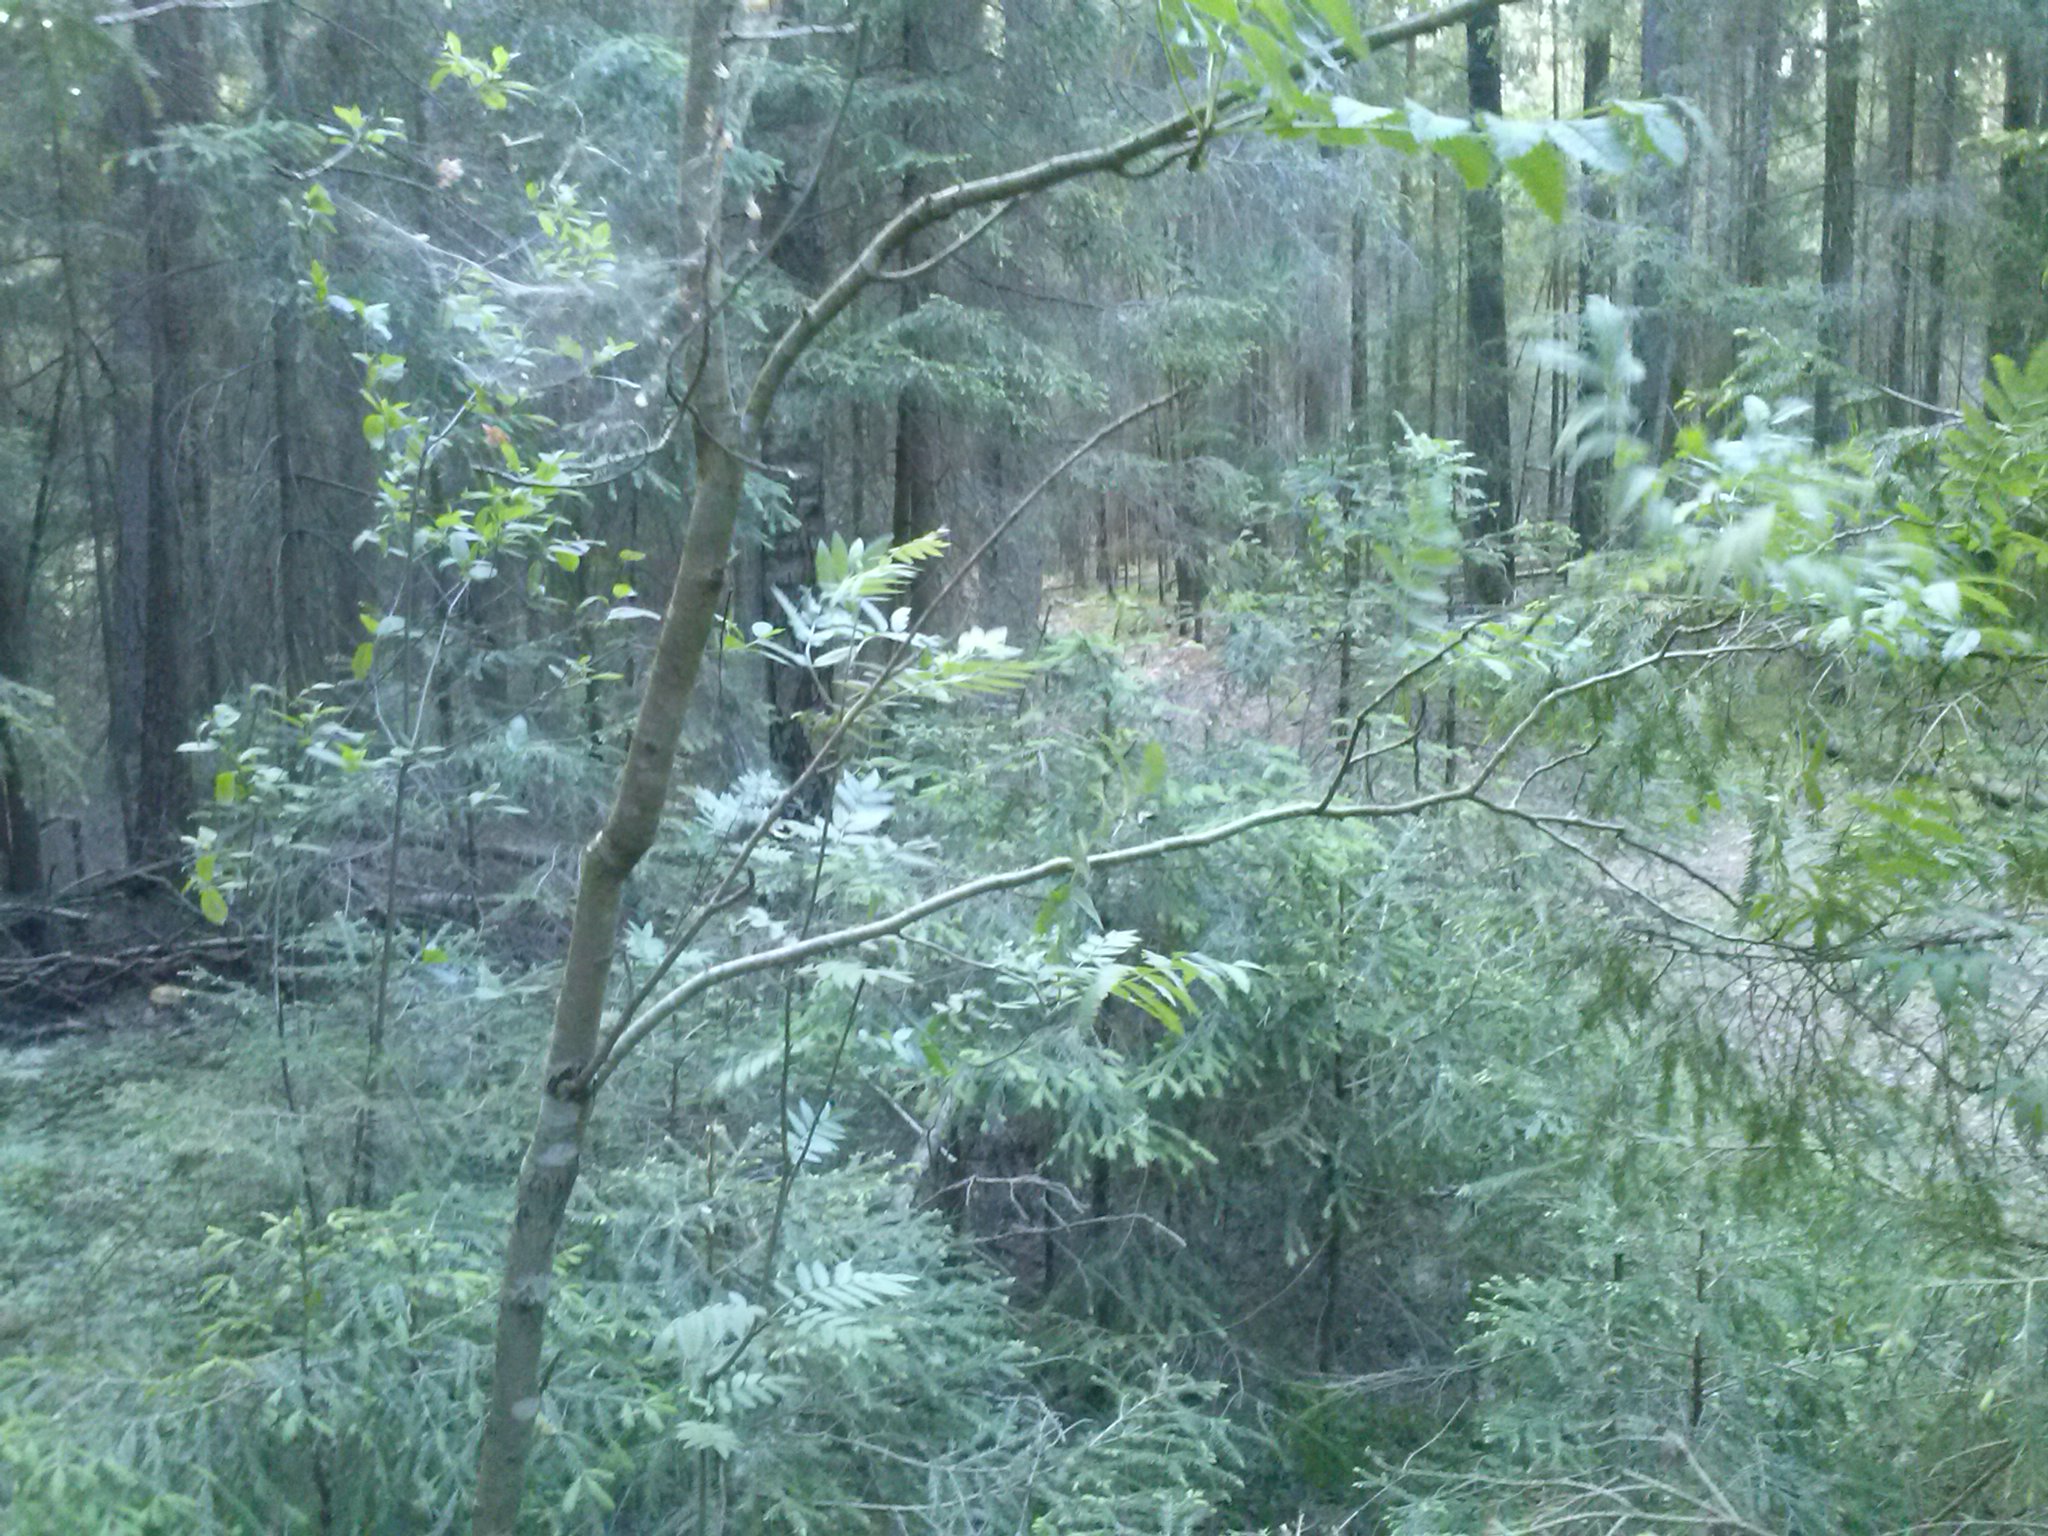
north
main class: Woodland
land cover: Spruce dominated coniferous woodland
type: hemiboreal forest and nemoral coniferous forest and mixed broadleaved-coniferous forest
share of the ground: > 75 %
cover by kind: coniferous forest trees 75 %, shrubs 10 %, herbaceous plants 10 %, unconsolidated bare surface 5 %
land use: Forestry
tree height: > 5 m
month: June
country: LV
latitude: 56.3660
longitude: 27.6857
